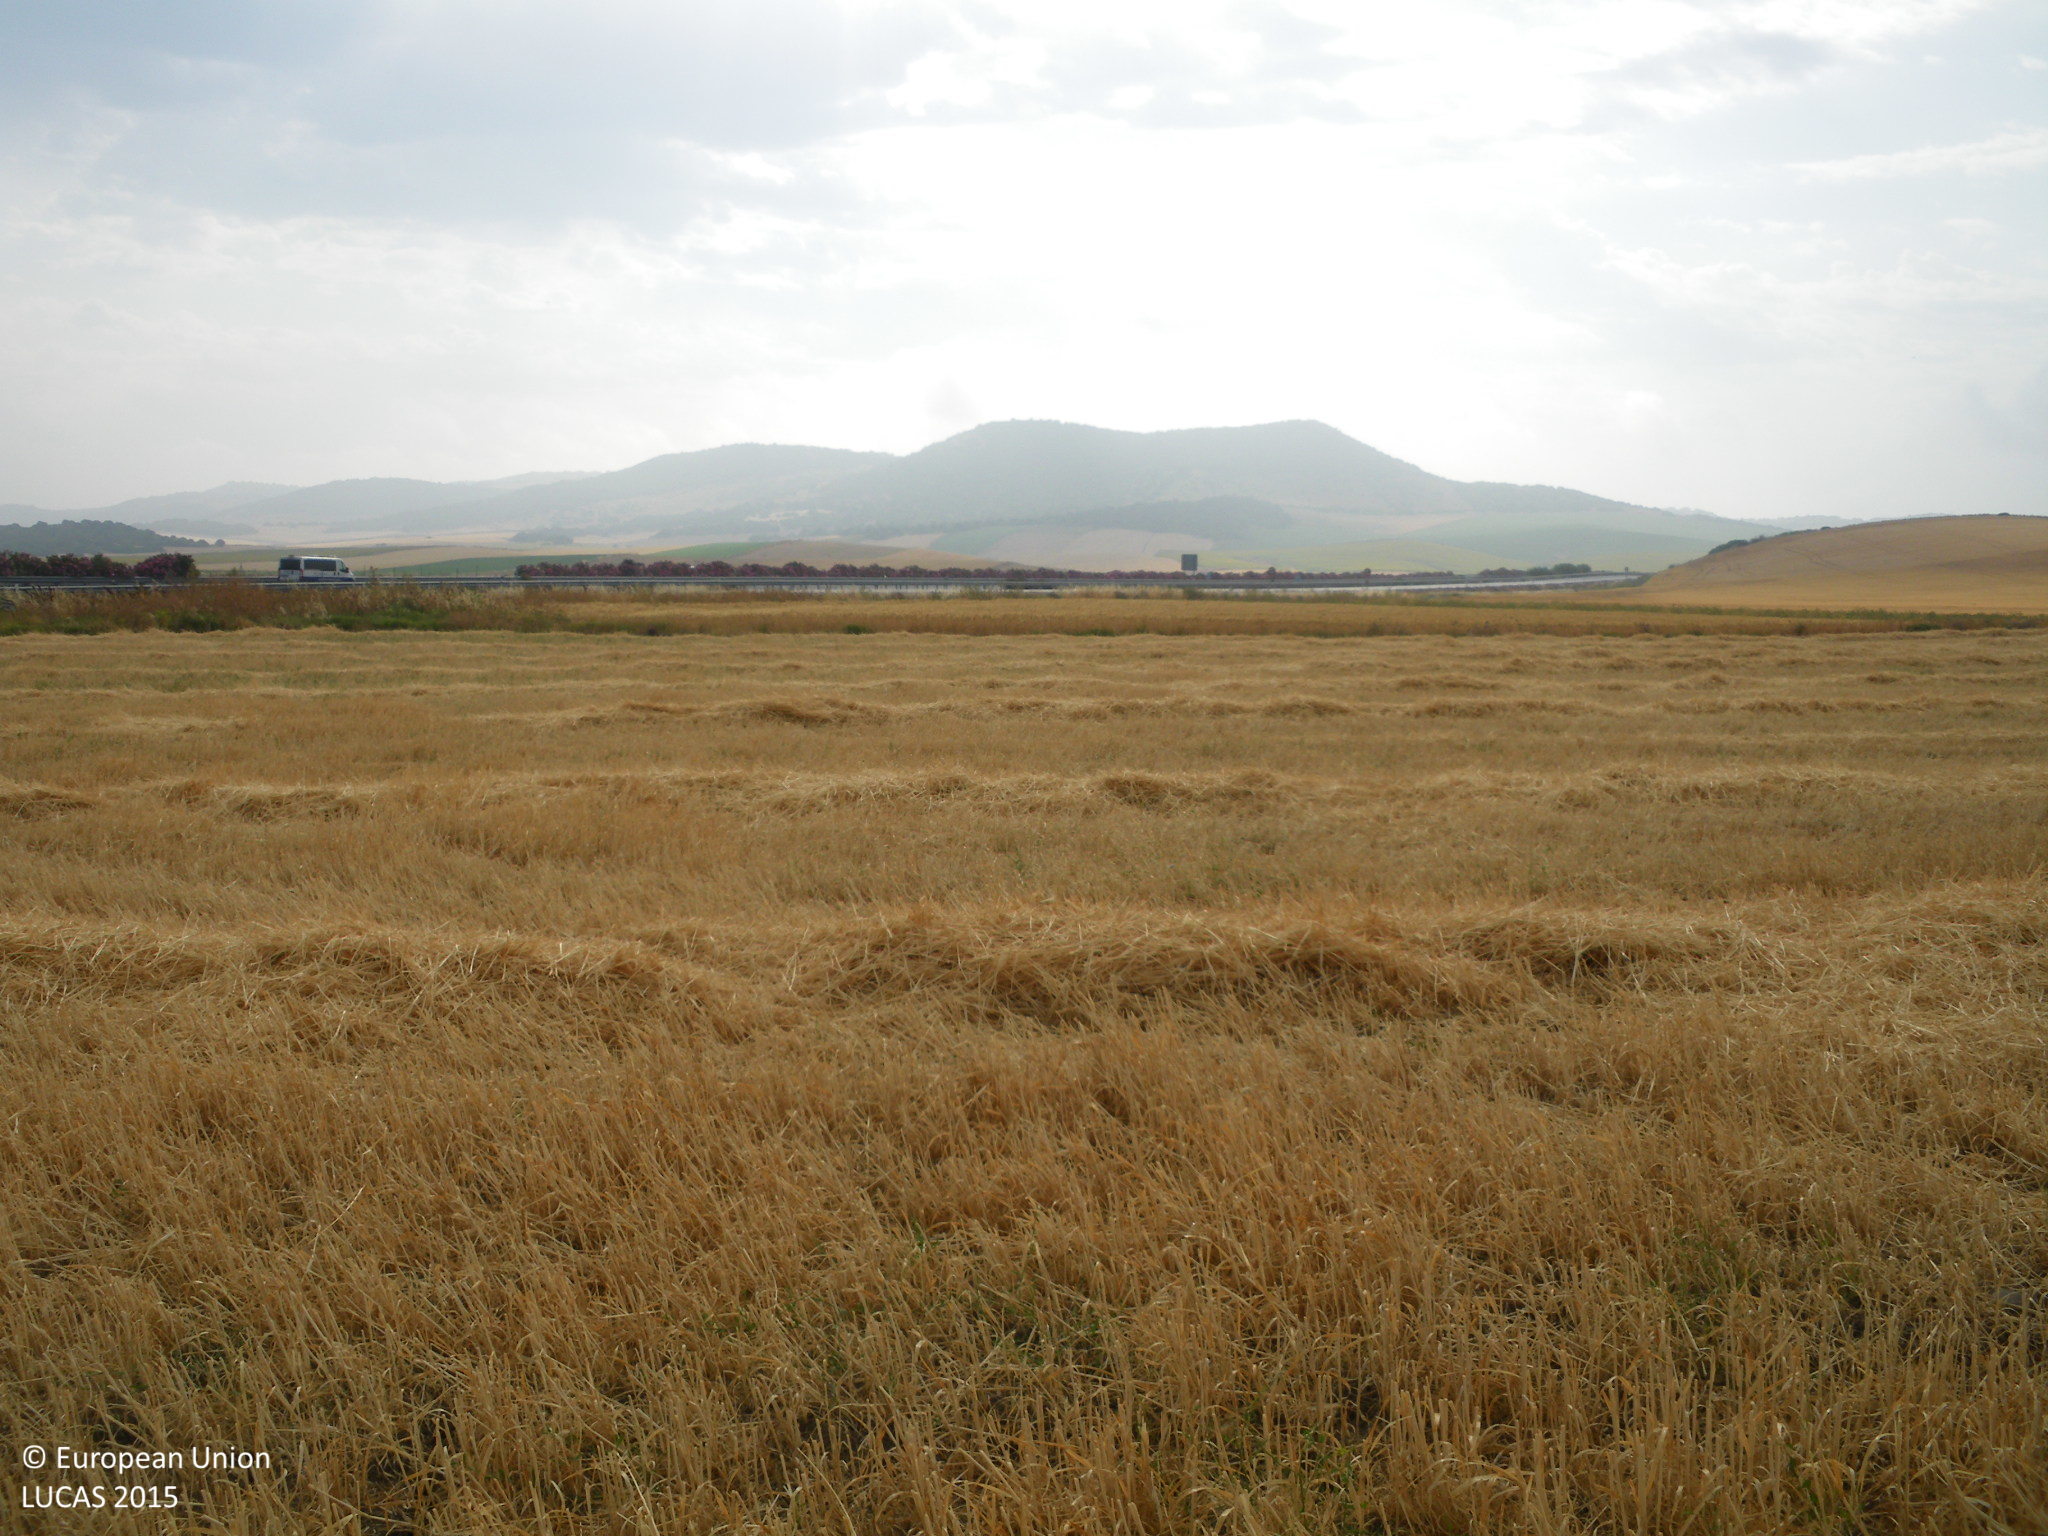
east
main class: Cropland
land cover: Triticale
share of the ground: < 10 %
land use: Agriculture (excluding fallow land and kitchen gardens)
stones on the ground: < 10 %
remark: Harvested field
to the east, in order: Triticale; Grass margins; Tracks; Spontaneously vegetated surfaces; Paved roads, cycling and walking lanes; Grass margins; Ditches and canals; Grass margins; Fences; Paved roads, cycling and walking lanes
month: June
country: ES
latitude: 36.2831
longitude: -6.0458
